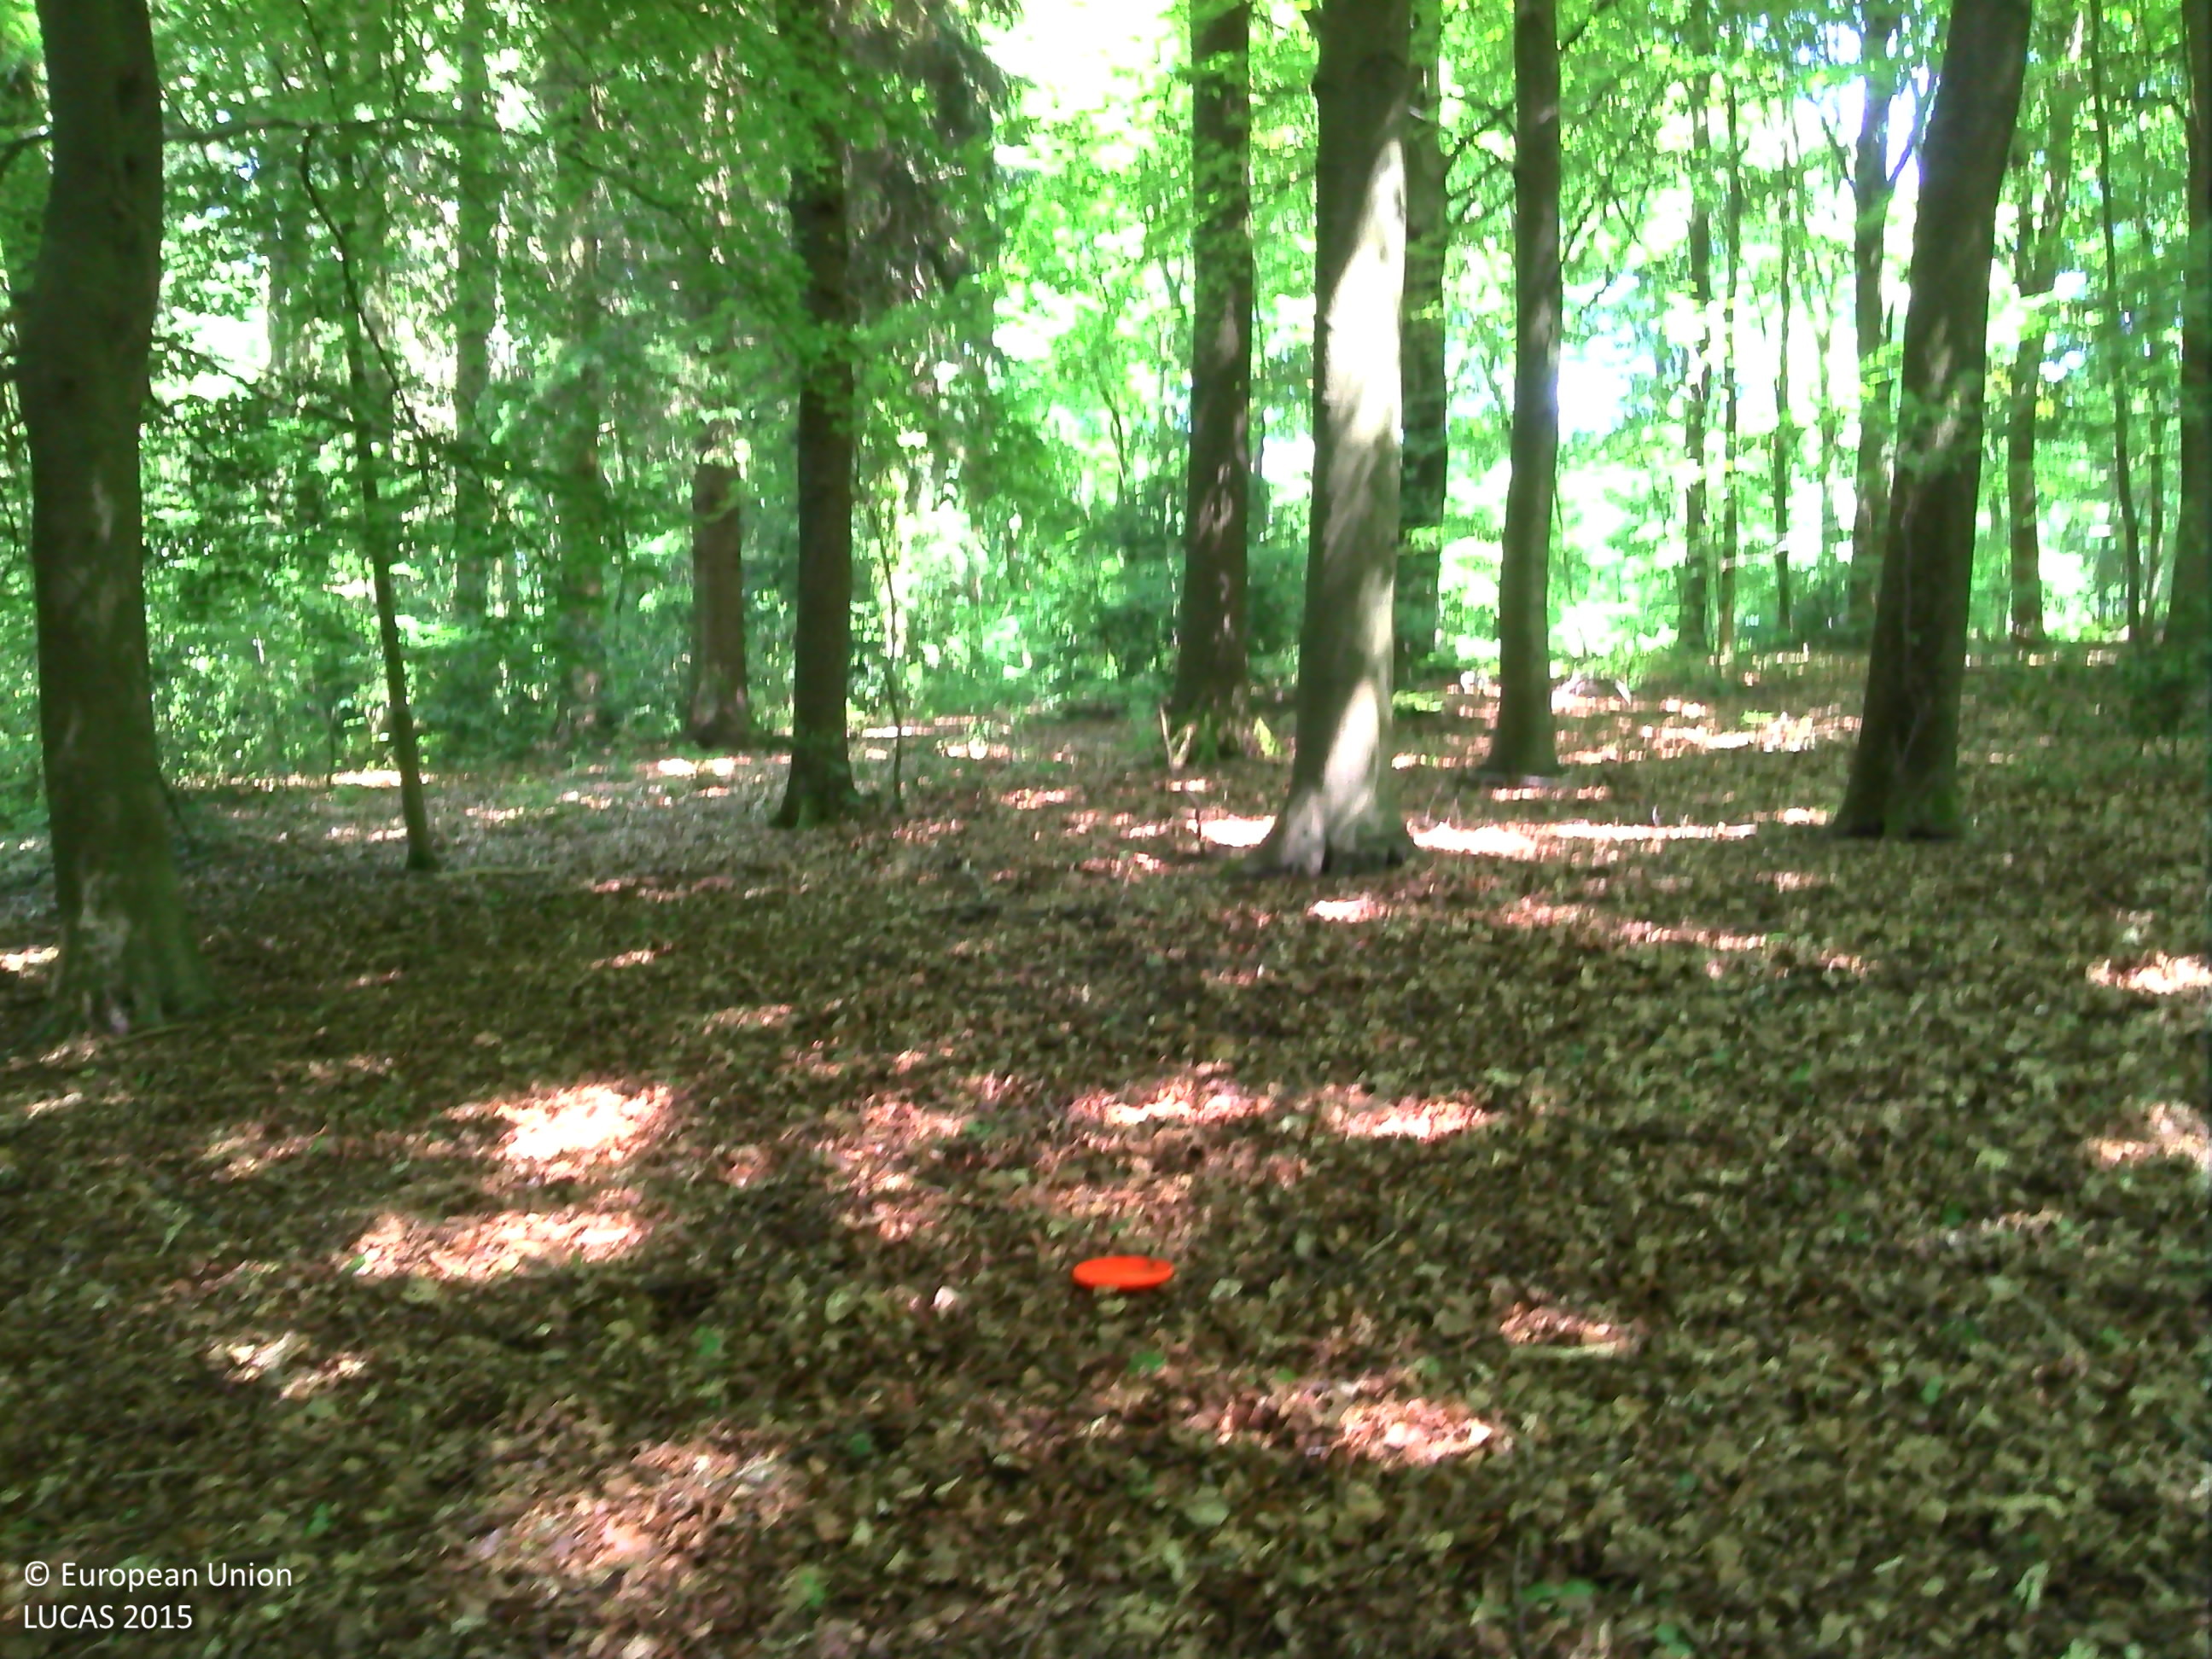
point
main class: Woodland
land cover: Broadleaved woodland
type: acidophilous oak and oak-birch forest
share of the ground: > 75 %
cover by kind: broadleaved forest trees 95 %, herbaceous plants 5 %
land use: Forestry
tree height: > 5 m
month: June
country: BE
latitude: 50.5646
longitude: 5.5229
